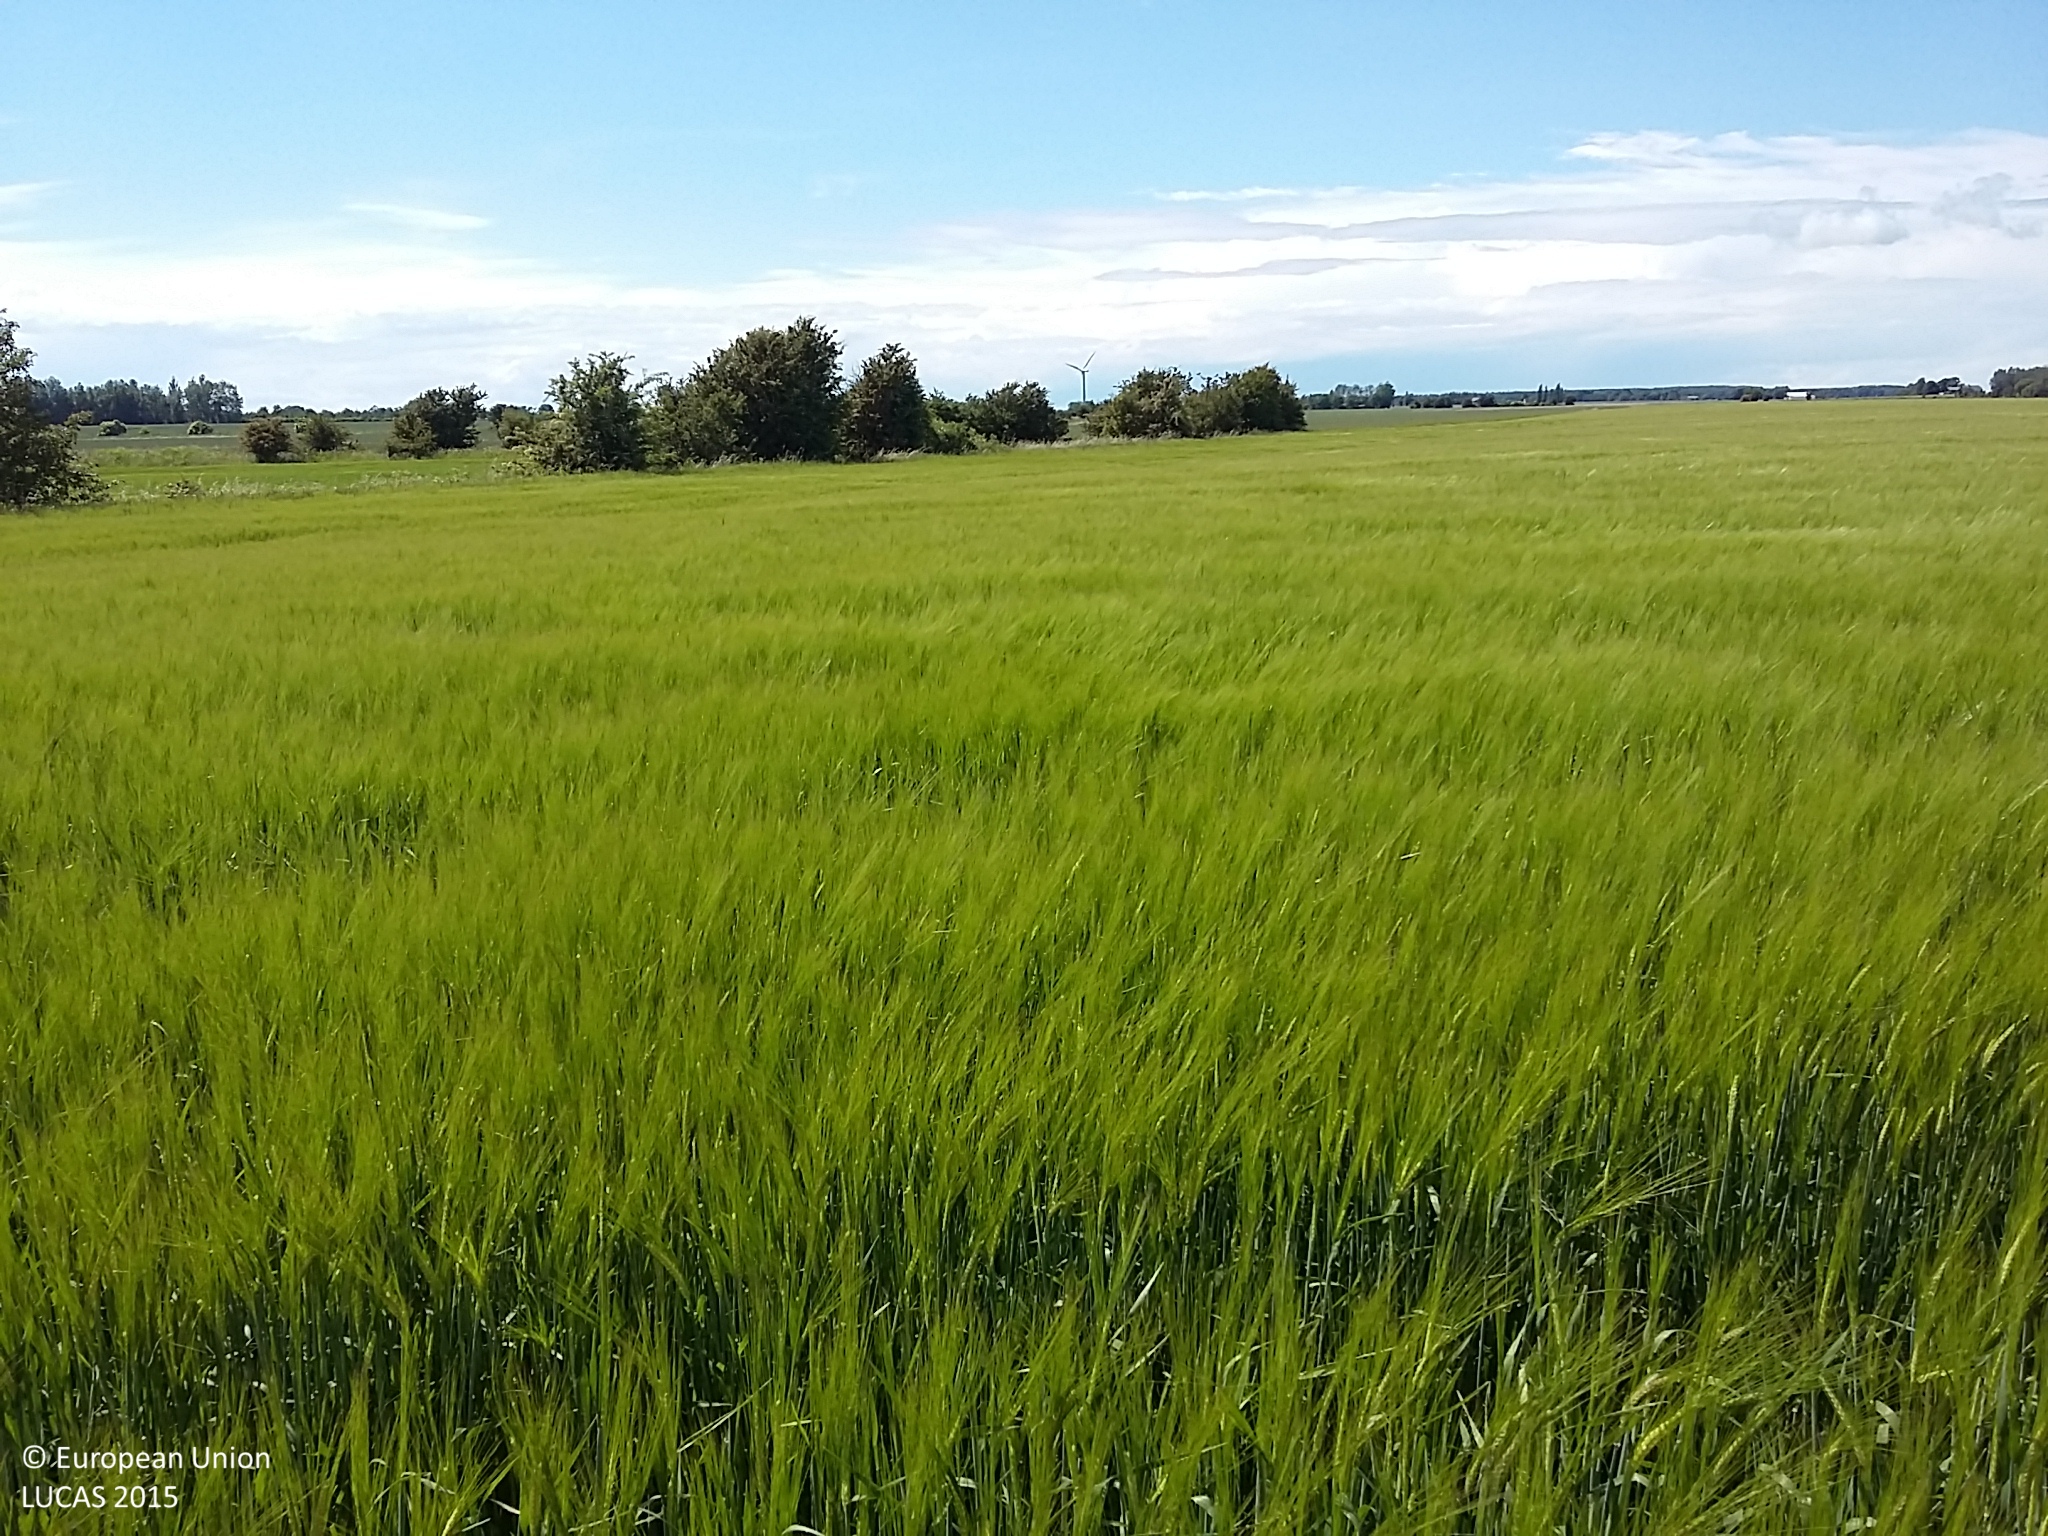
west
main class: Cropland
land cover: Barley
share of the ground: > 75 %
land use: Agriculture (excluding fallow land and kitchen gardens)
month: June
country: DK
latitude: 54.7258
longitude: 11.2258
